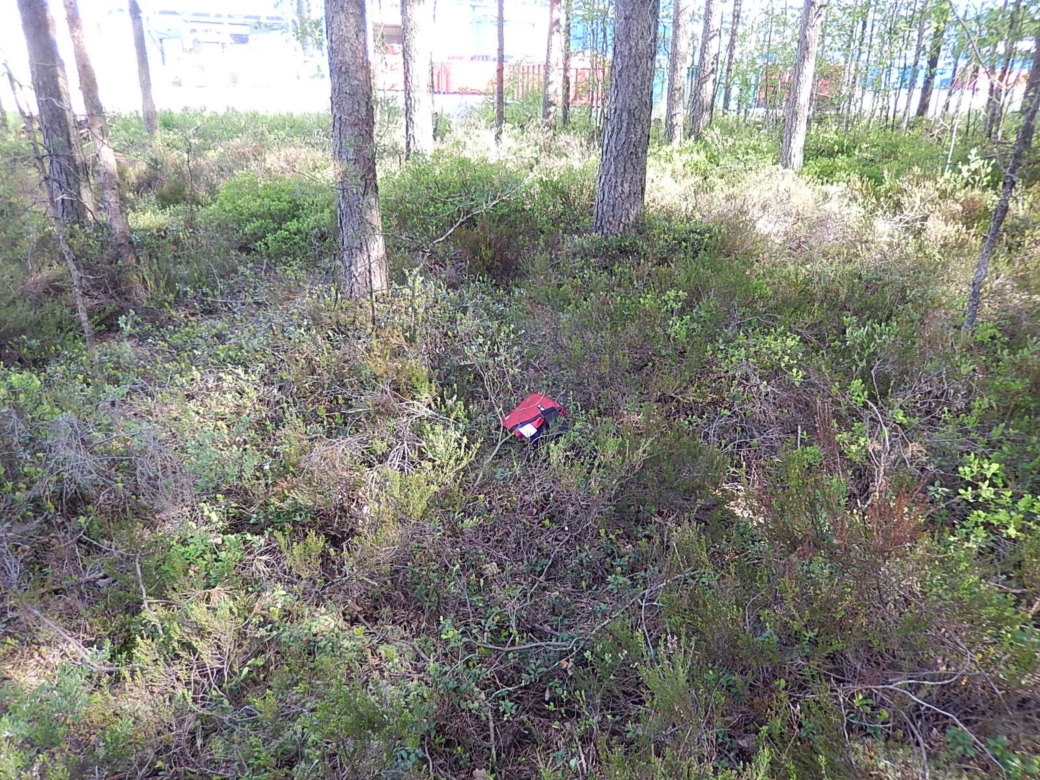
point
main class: Woodland
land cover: Pine dominated coniferous woodland
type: boreal forest
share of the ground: > 75 %
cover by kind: coniferous forest trees 75 %, shrubs 15 %, broadleaved forest trees 10 %
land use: Forestry
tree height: > 5 m
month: June
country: FI
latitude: 61.9789
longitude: 22.2876
